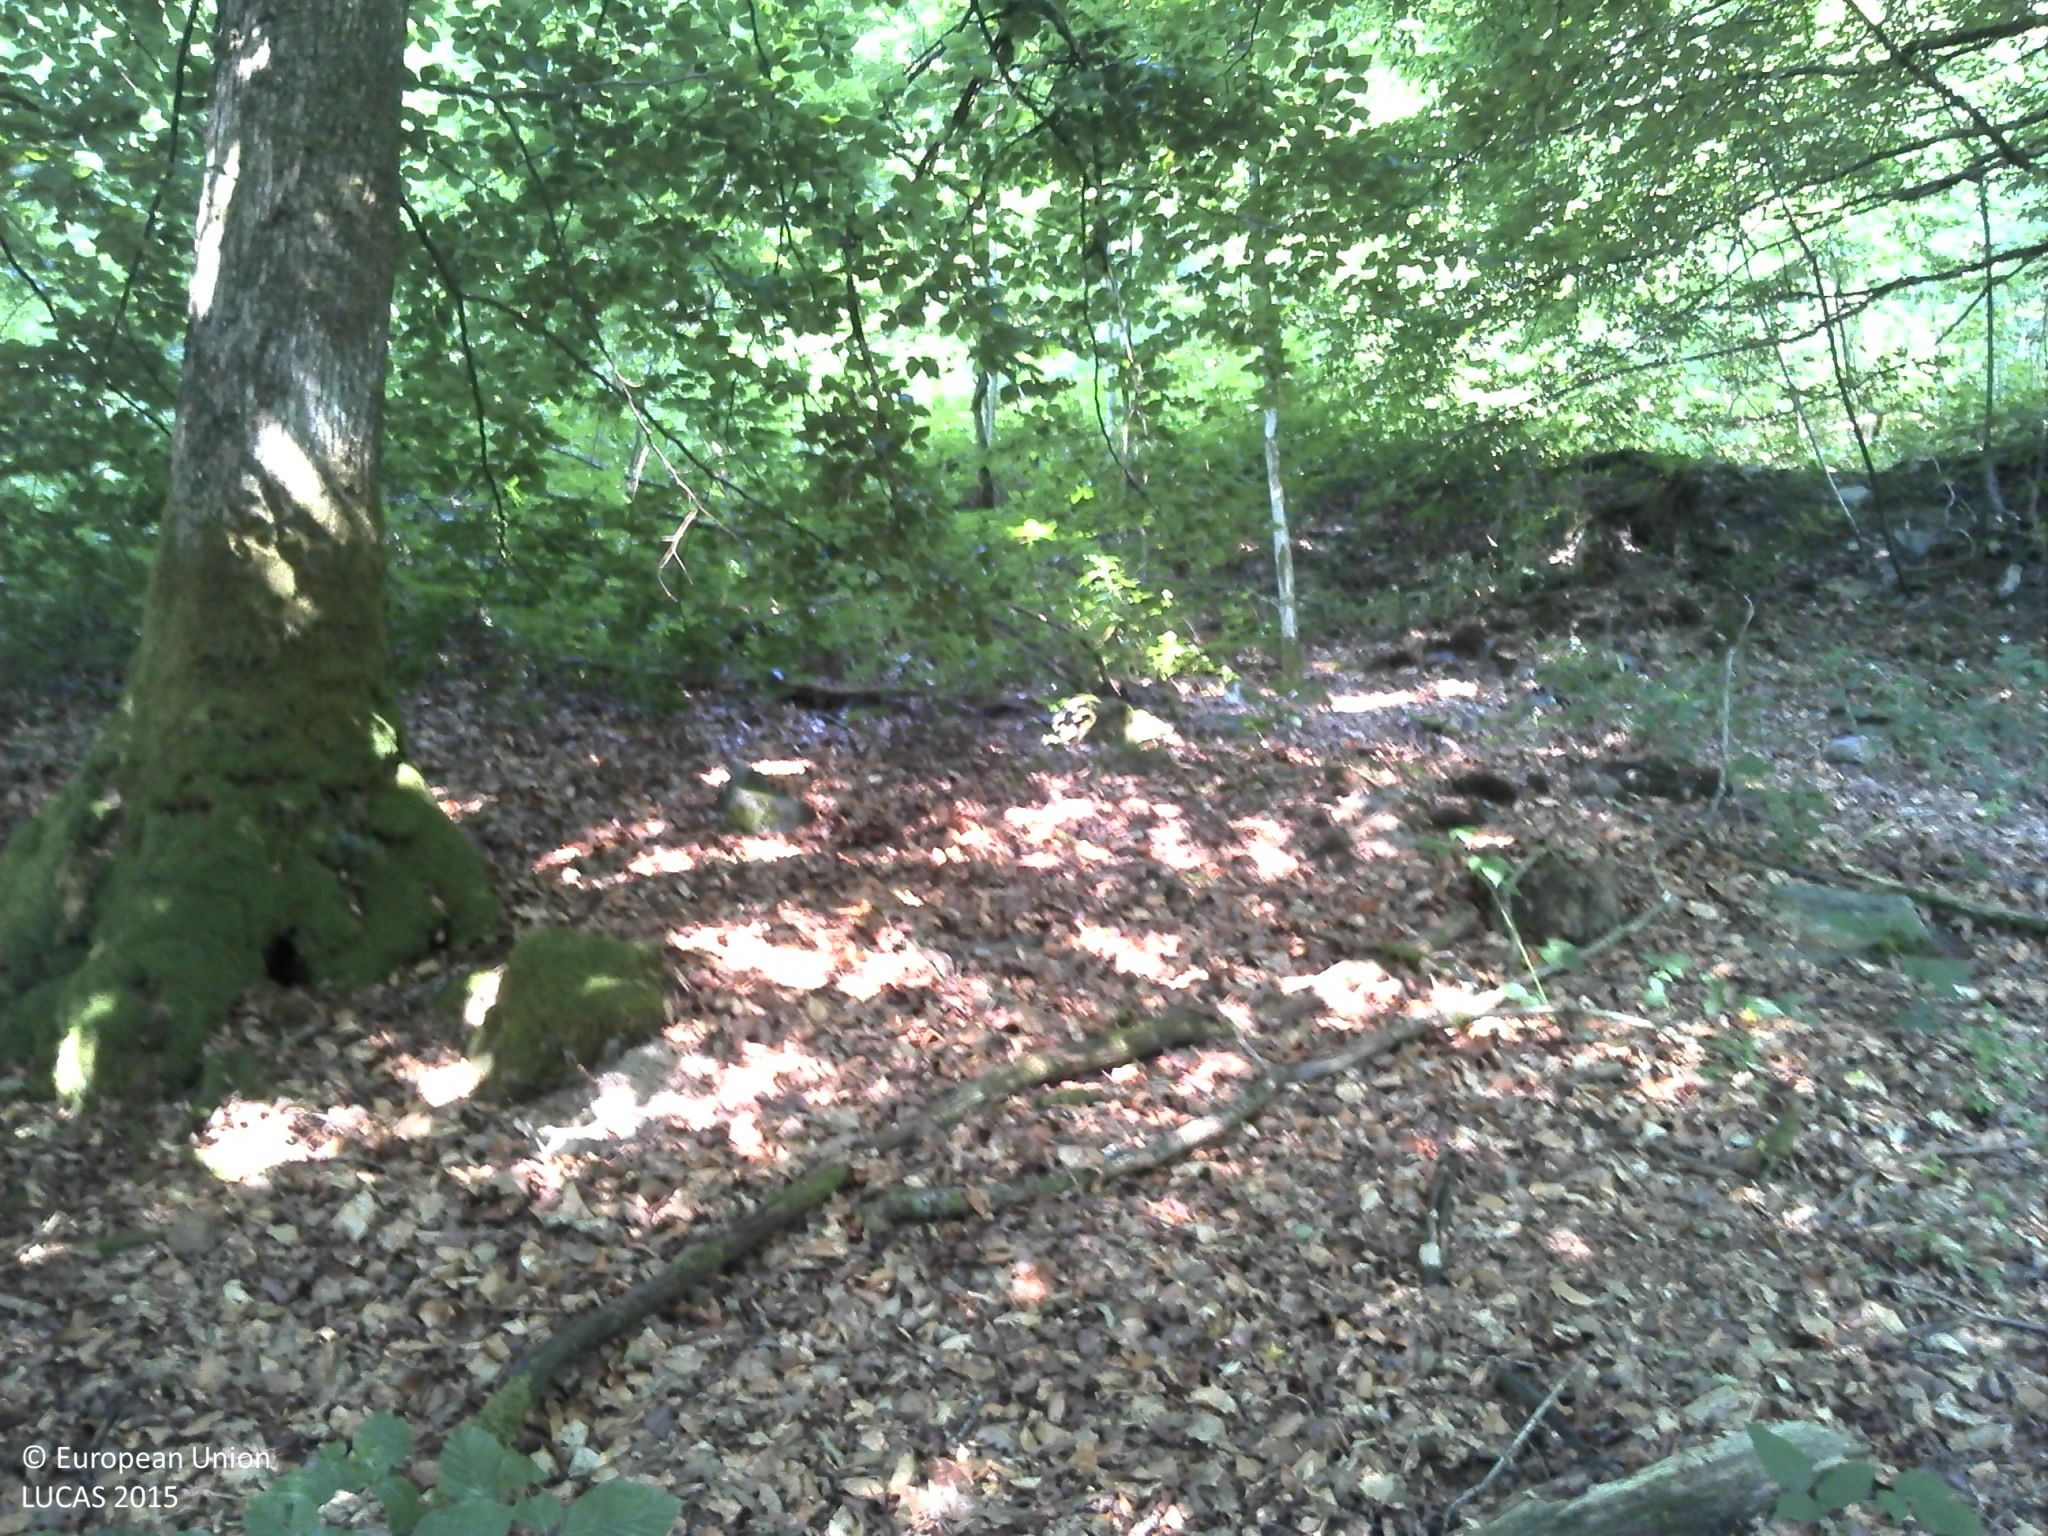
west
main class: Woodland
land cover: Broadleaved woodland
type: beech forest
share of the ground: 50 - 75 %
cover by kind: broadleaved forest trees 70 %, herbaceous plants 20 %, lichens and mosses 5 %, consolidated bare surface 5 %
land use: Forestry
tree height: > 5 m
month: July
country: FR
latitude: 49.9111
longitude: 4.5793
